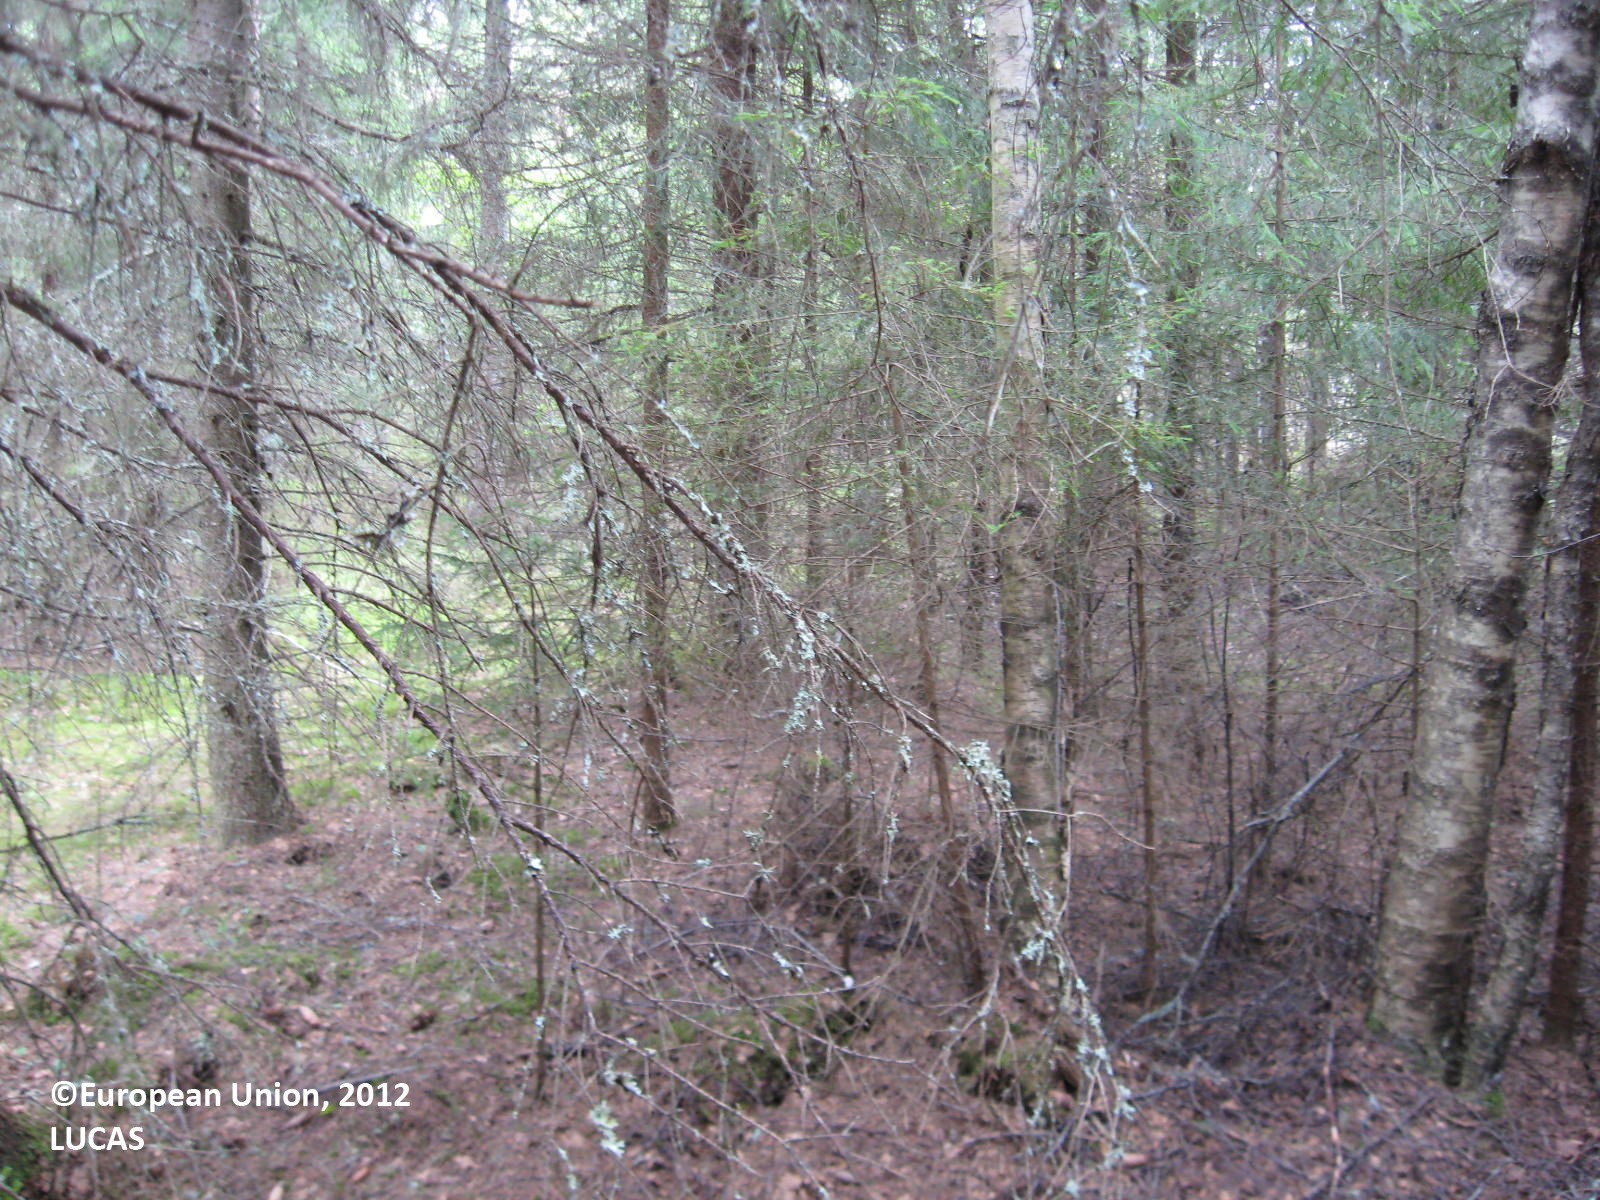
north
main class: Woodland
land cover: Spruce dominated coniferous woodland
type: boreal forest
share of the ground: > 75 %
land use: Forestry
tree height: > 5 m
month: July
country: FI
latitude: 62.0335
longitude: 21.3805
